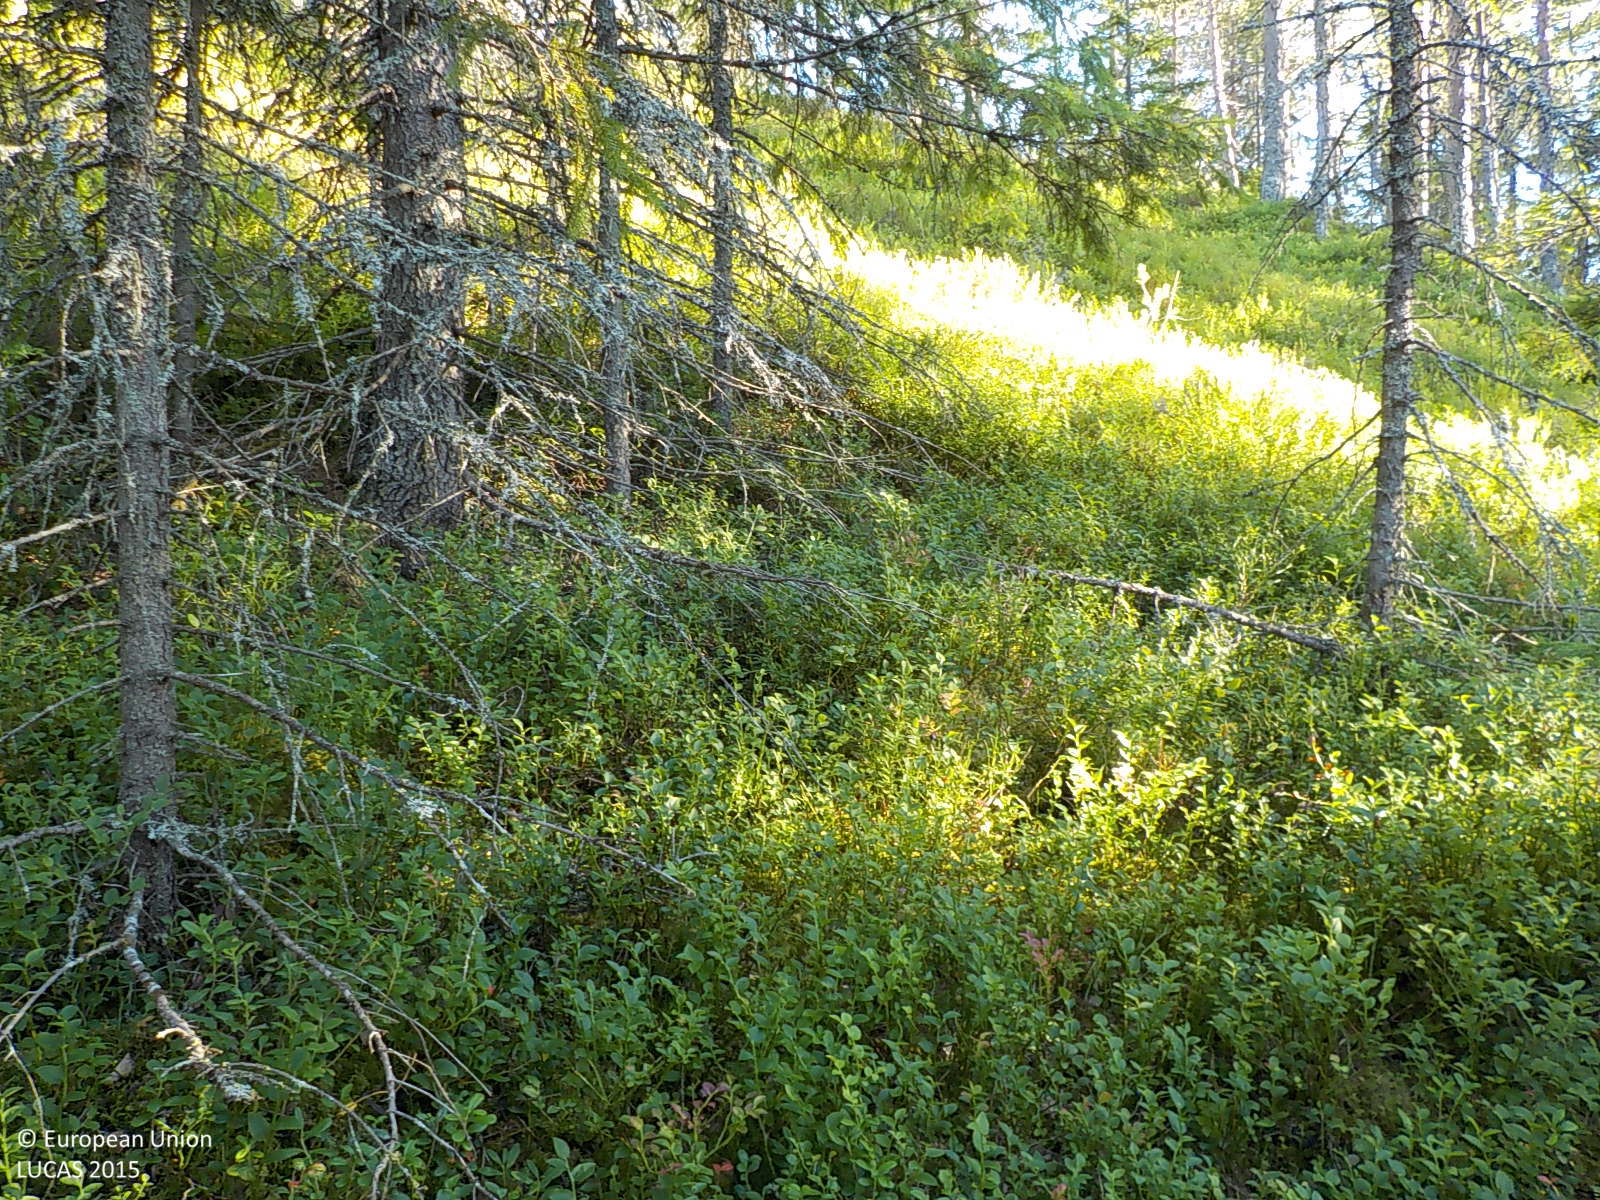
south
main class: Woodland
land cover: Spruce dominated coniferous woodland
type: boreal forest
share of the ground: 50 - 75 %
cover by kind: coniferous forest trees 75 %, shrubs 25 %
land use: Forestry
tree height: > 5 m
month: August
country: SE
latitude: 63.3720
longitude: 18.7973
